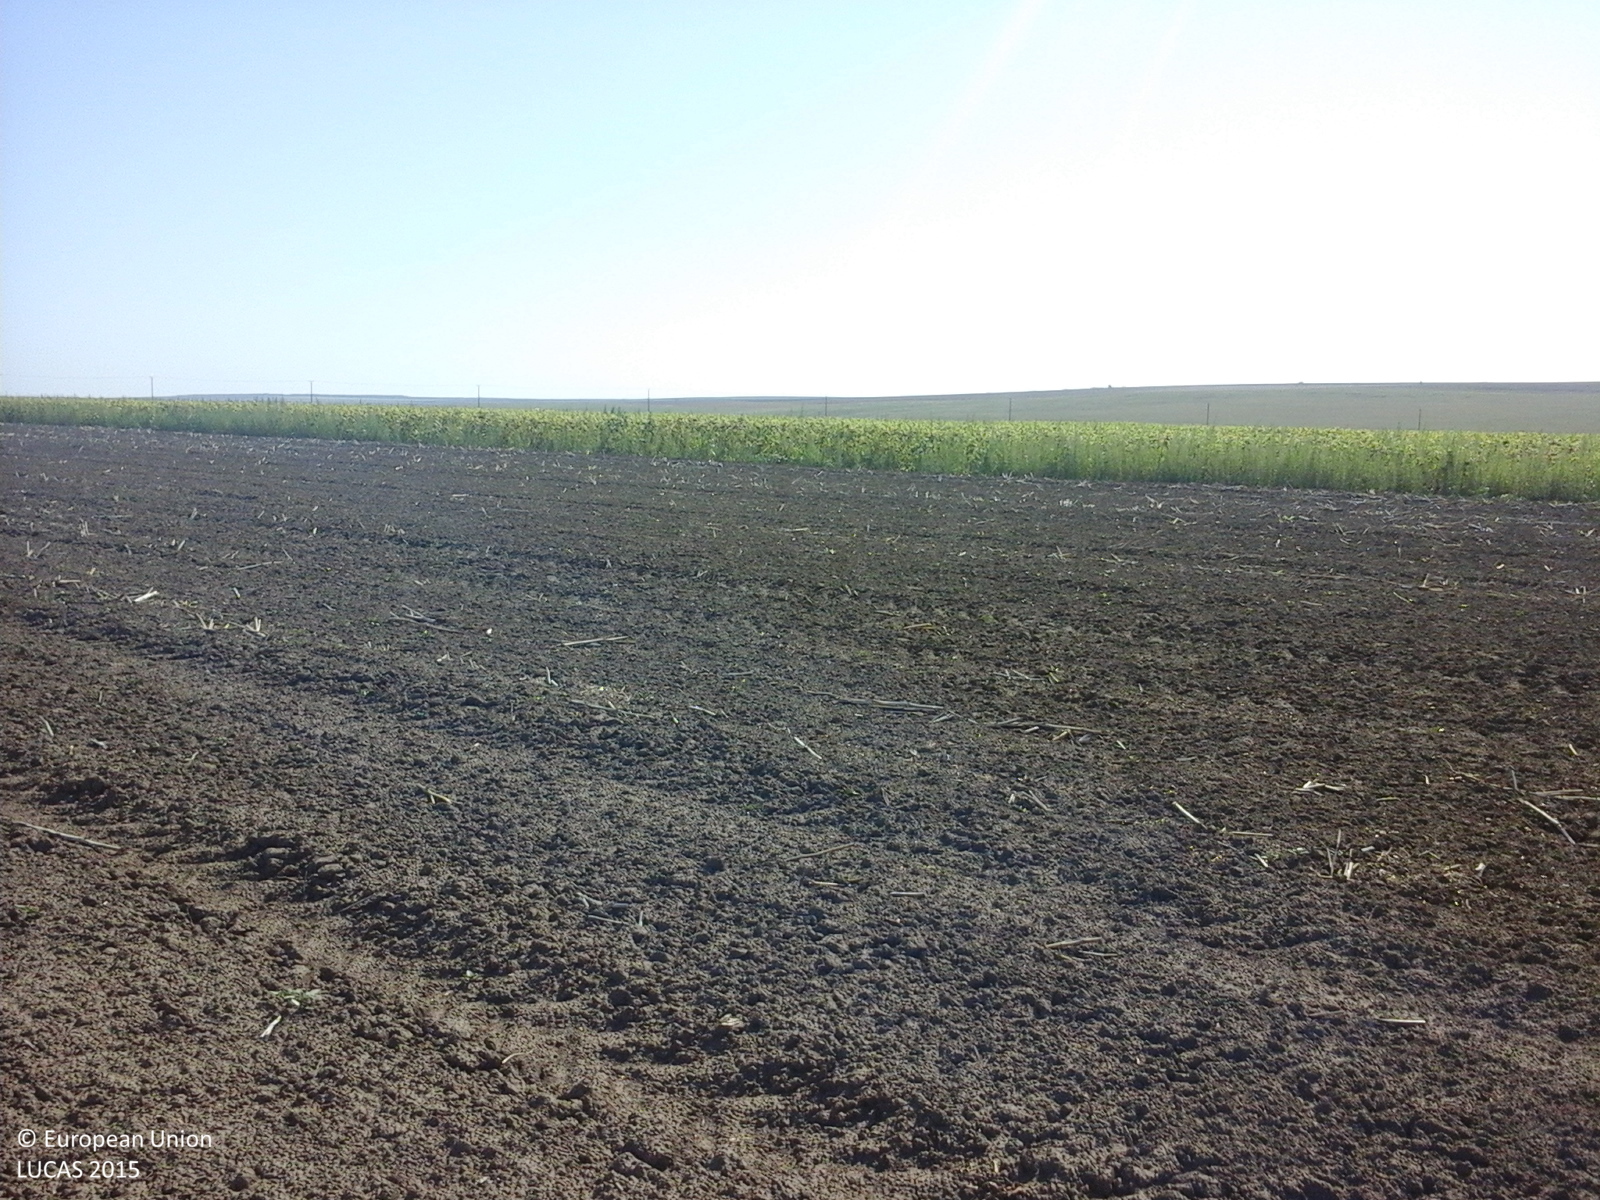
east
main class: Cropland
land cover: Rape and turnip rape
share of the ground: < 10 %
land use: Agriculture (excluding fallow land and kitchen gardens)
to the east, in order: Rape and turnip rape; Shruby margins; Sunflower; Lucerne
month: August
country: RO
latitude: 44.3151
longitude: 28.3846
